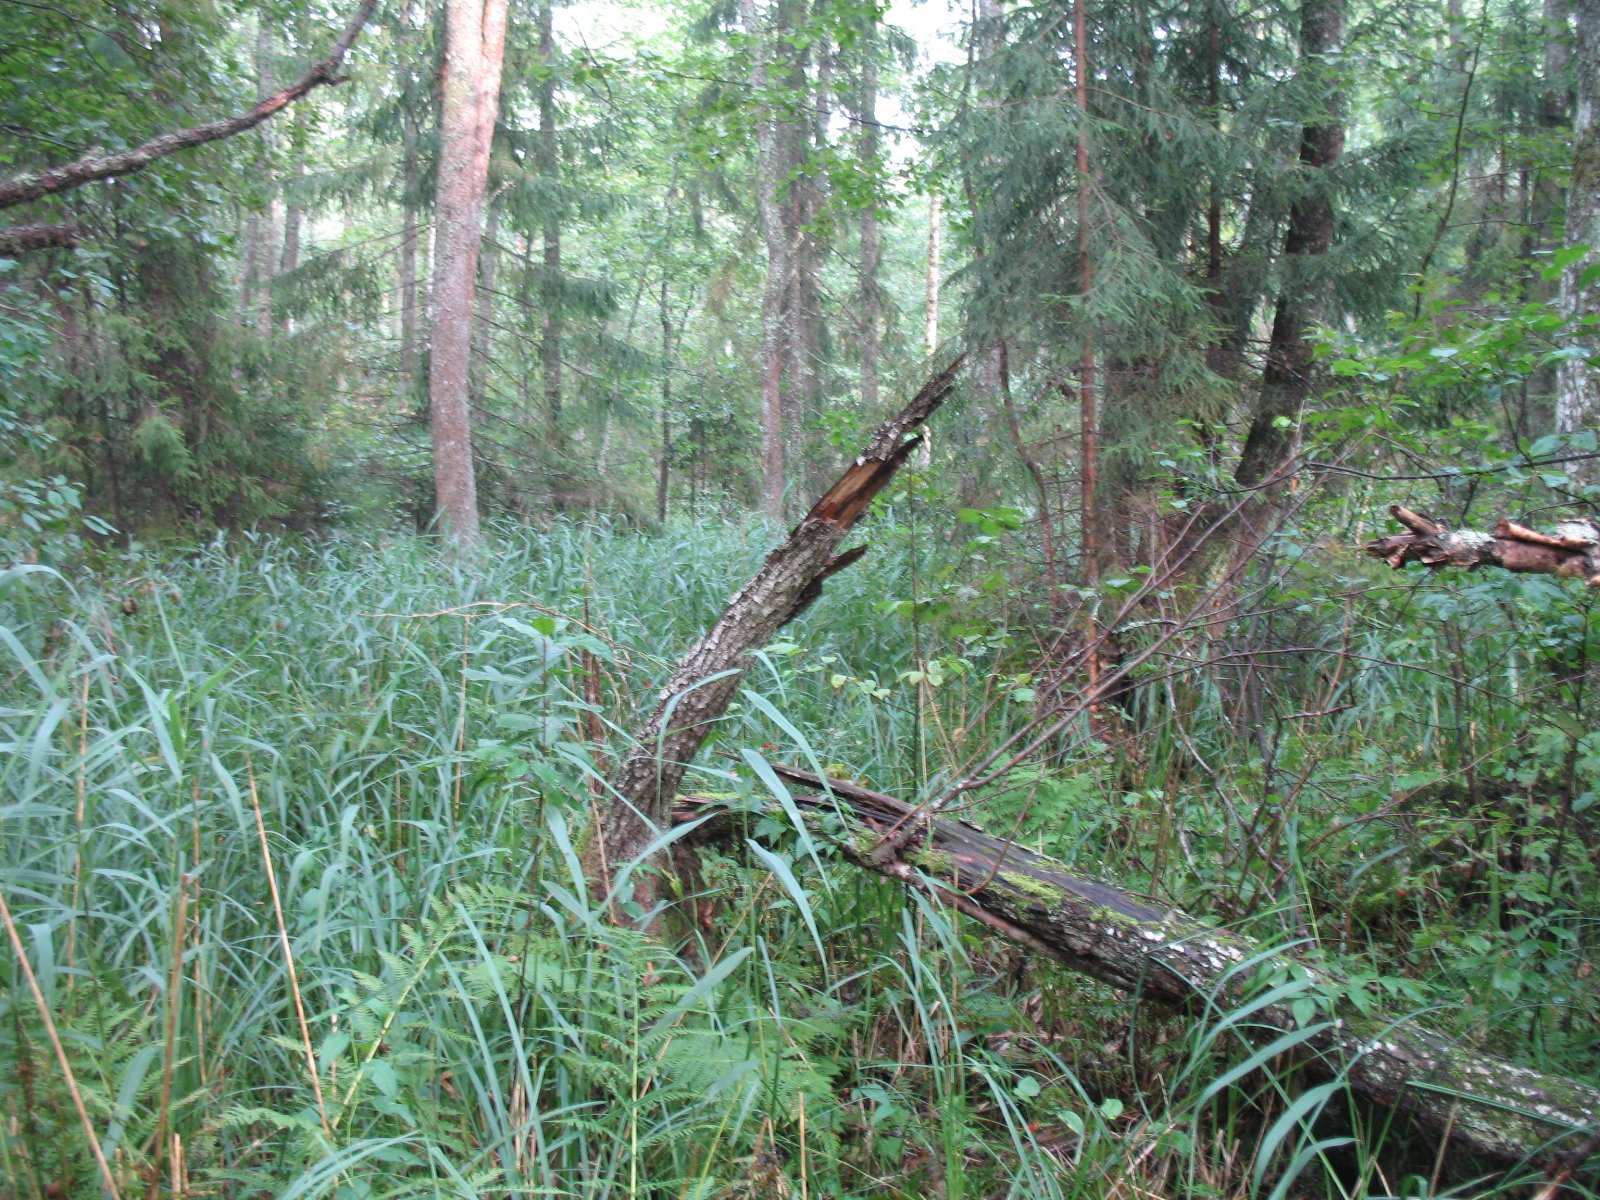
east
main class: Woodland
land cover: Broadleaved woodland
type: mire and swamp forests
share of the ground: > 75 %
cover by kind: broadleaved forest trees 75 %, herbaceous plants 15 %, coniferous forest trees 10 %
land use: Forestry
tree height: > 5 m
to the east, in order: Broadleaved woodland; Spruce dominated mixed woodland; Broadleaved woodland; Spruce dominated mixed woodland; Spruce dominated coniferous woodland
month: September
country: LV
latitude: 56.1601
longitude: 26.1937
